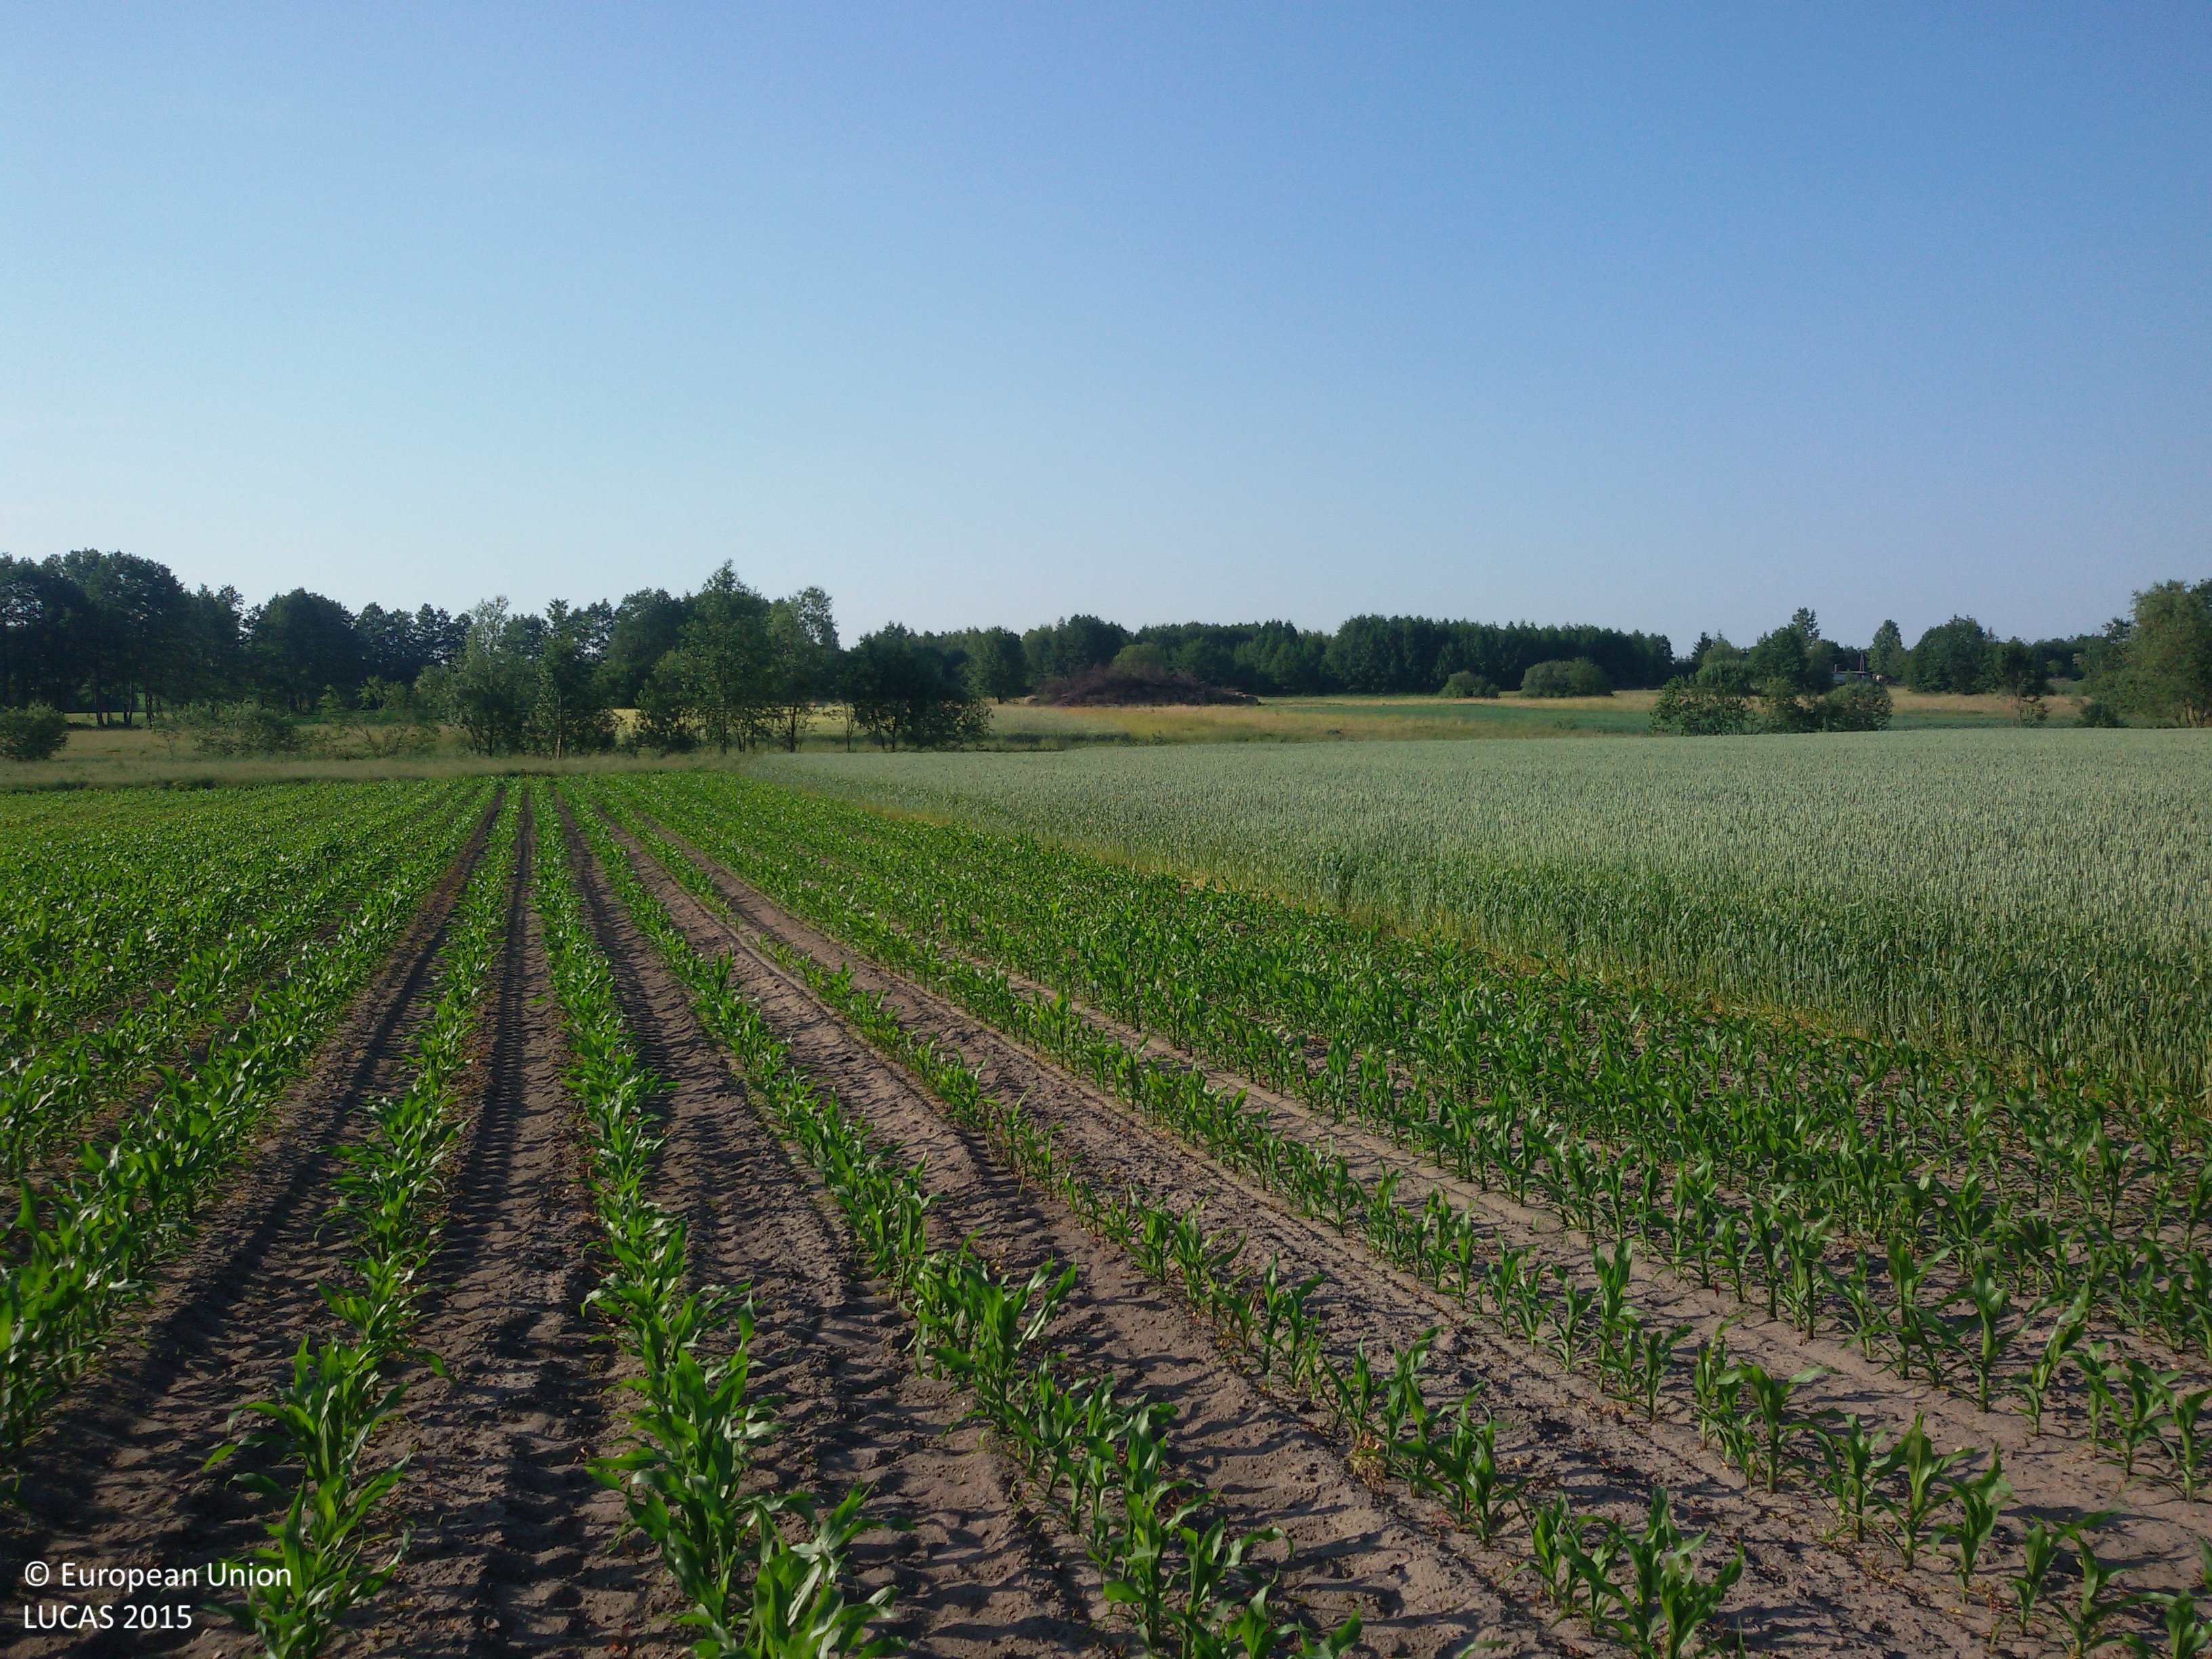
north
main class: Cropland
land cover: Maize
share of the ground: 50 - 75 %
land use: Agriculture (excluding fallow land and kitchen gardens)
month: June
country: PL
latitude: 52.4836
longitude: 19.0501
